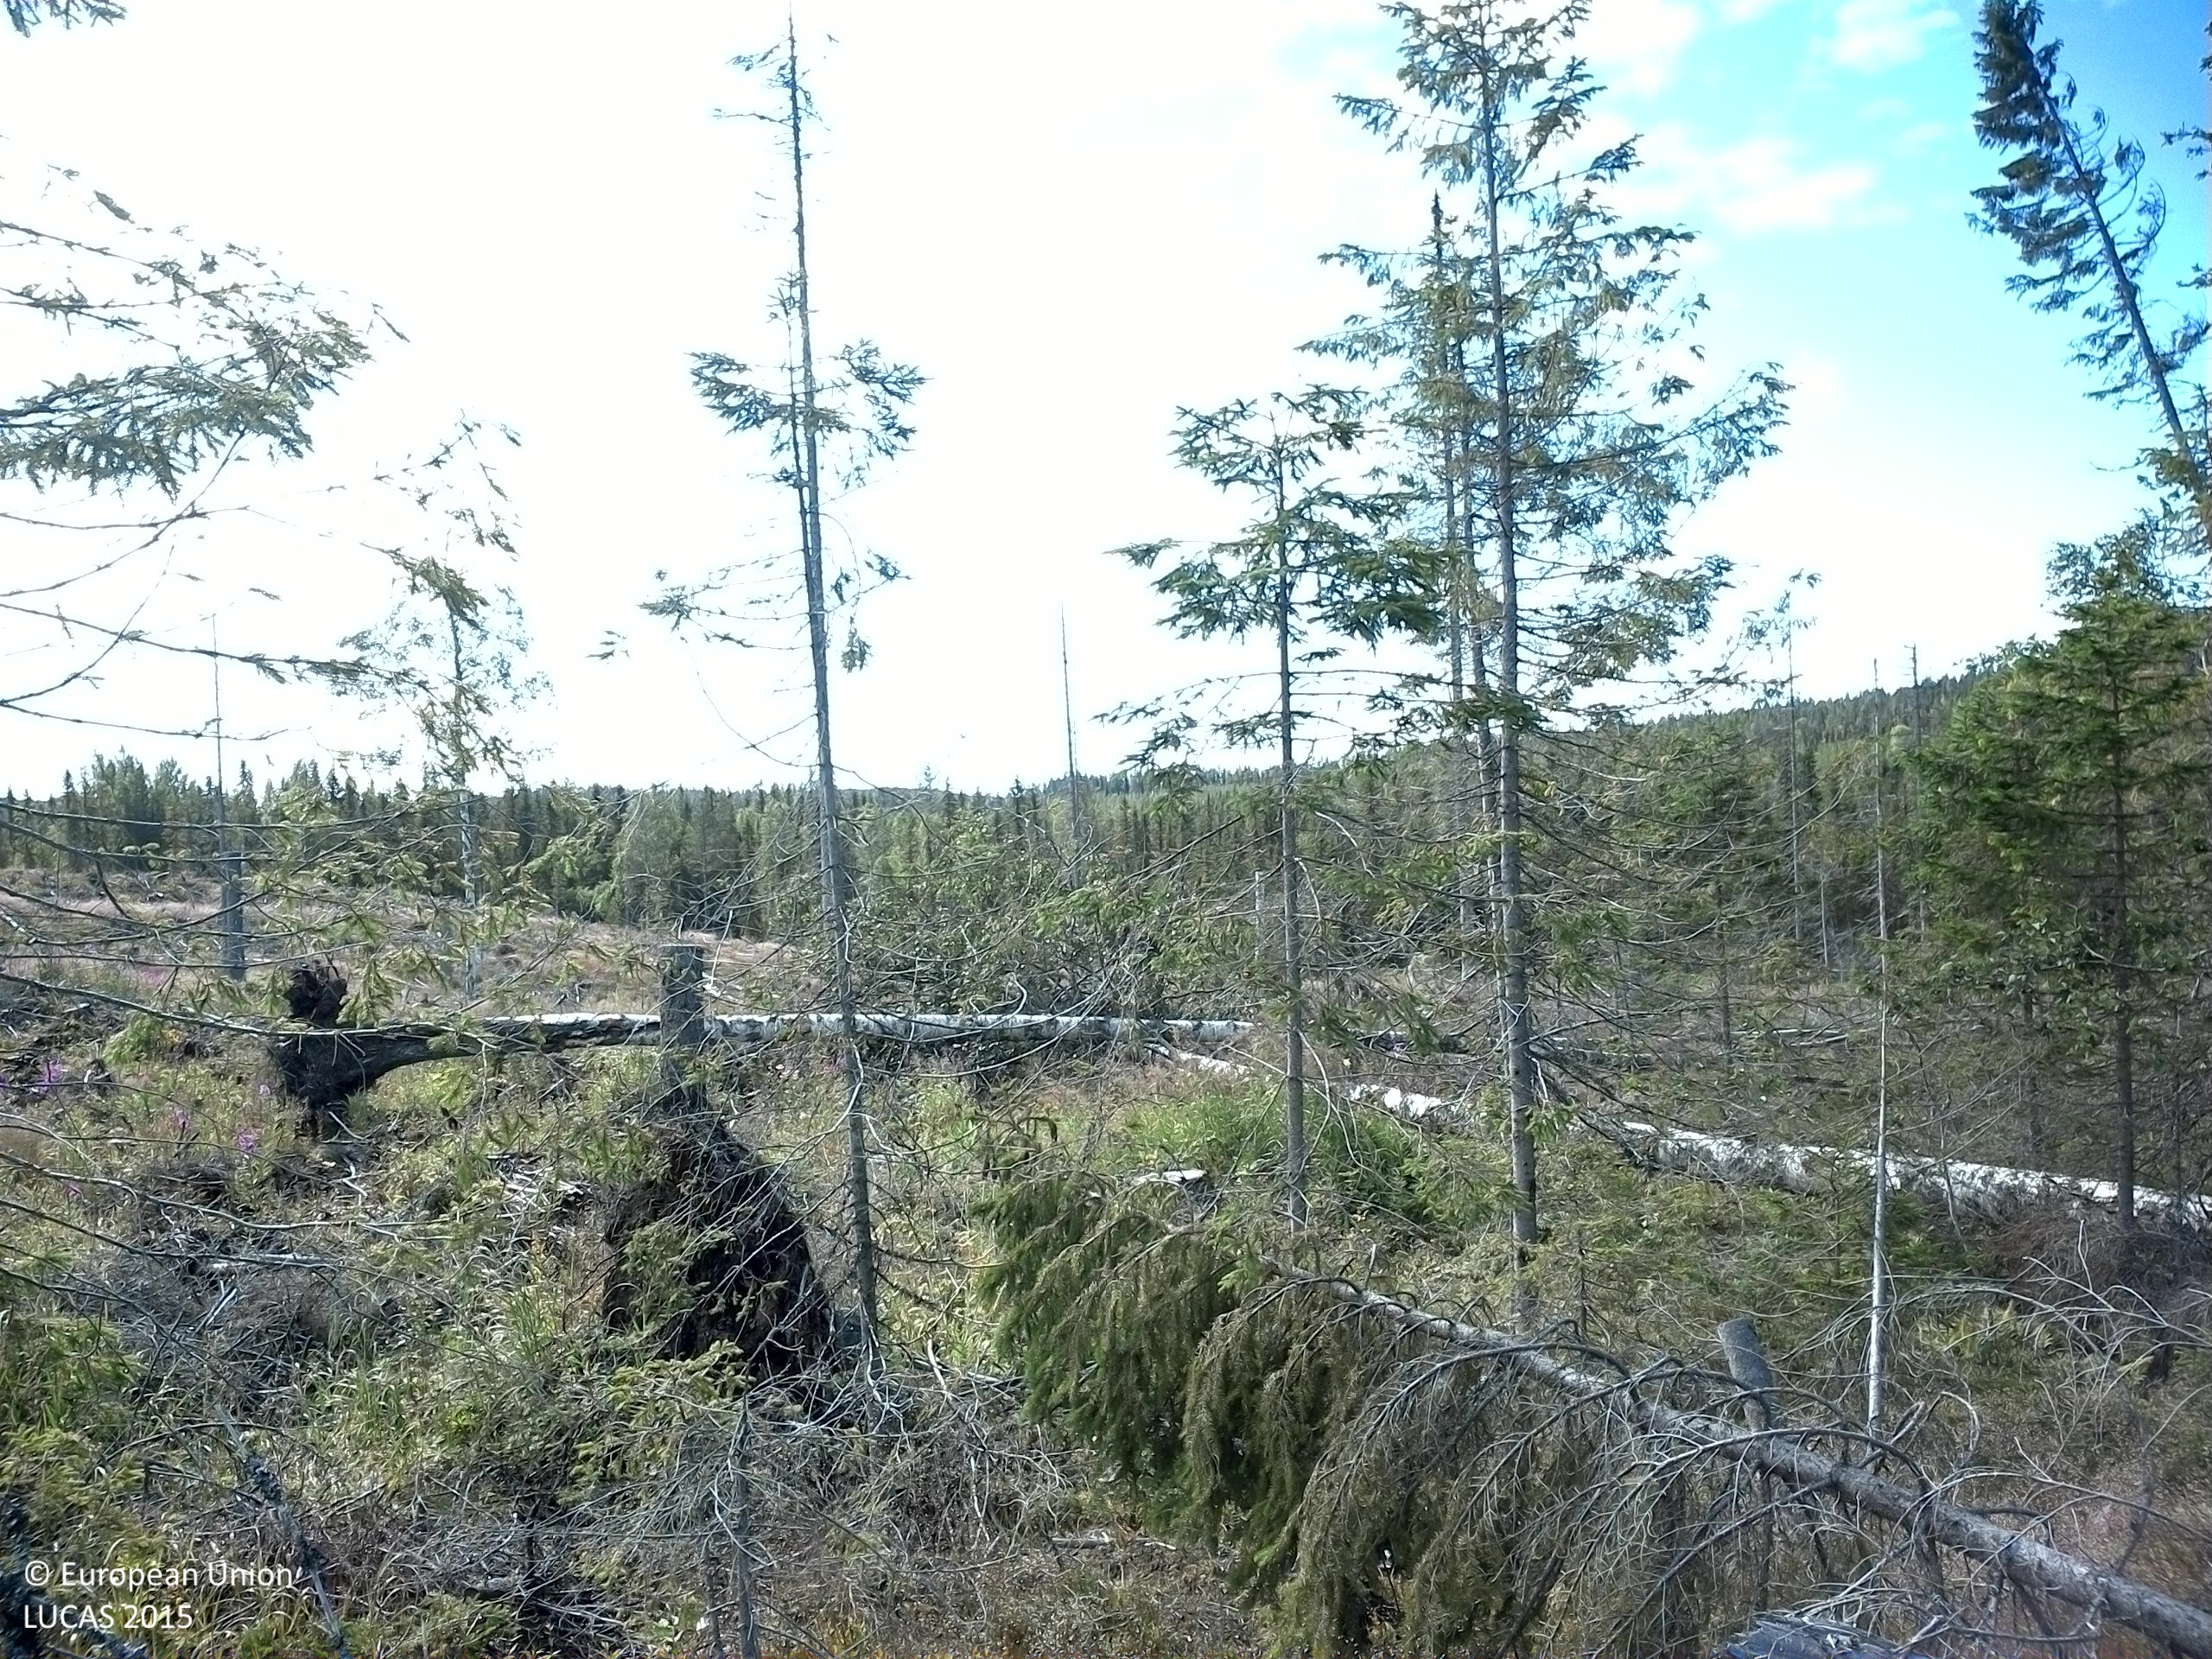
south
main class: Woodland
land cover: Spruce dominated mixed woodland
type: boreal forest
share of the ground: 10 - 25 %
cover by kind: shrubs 45 %, herbaceous plants 25 %, coniferous forest trees 10 %, lichens and mosses 10 %, broadleaved forest trees 5 %, consolidated bare surface 5 %
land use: Forestry
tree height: < 5 m
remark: Clear cut
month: August
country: SE
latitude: 62.8496
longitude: 16.5577
